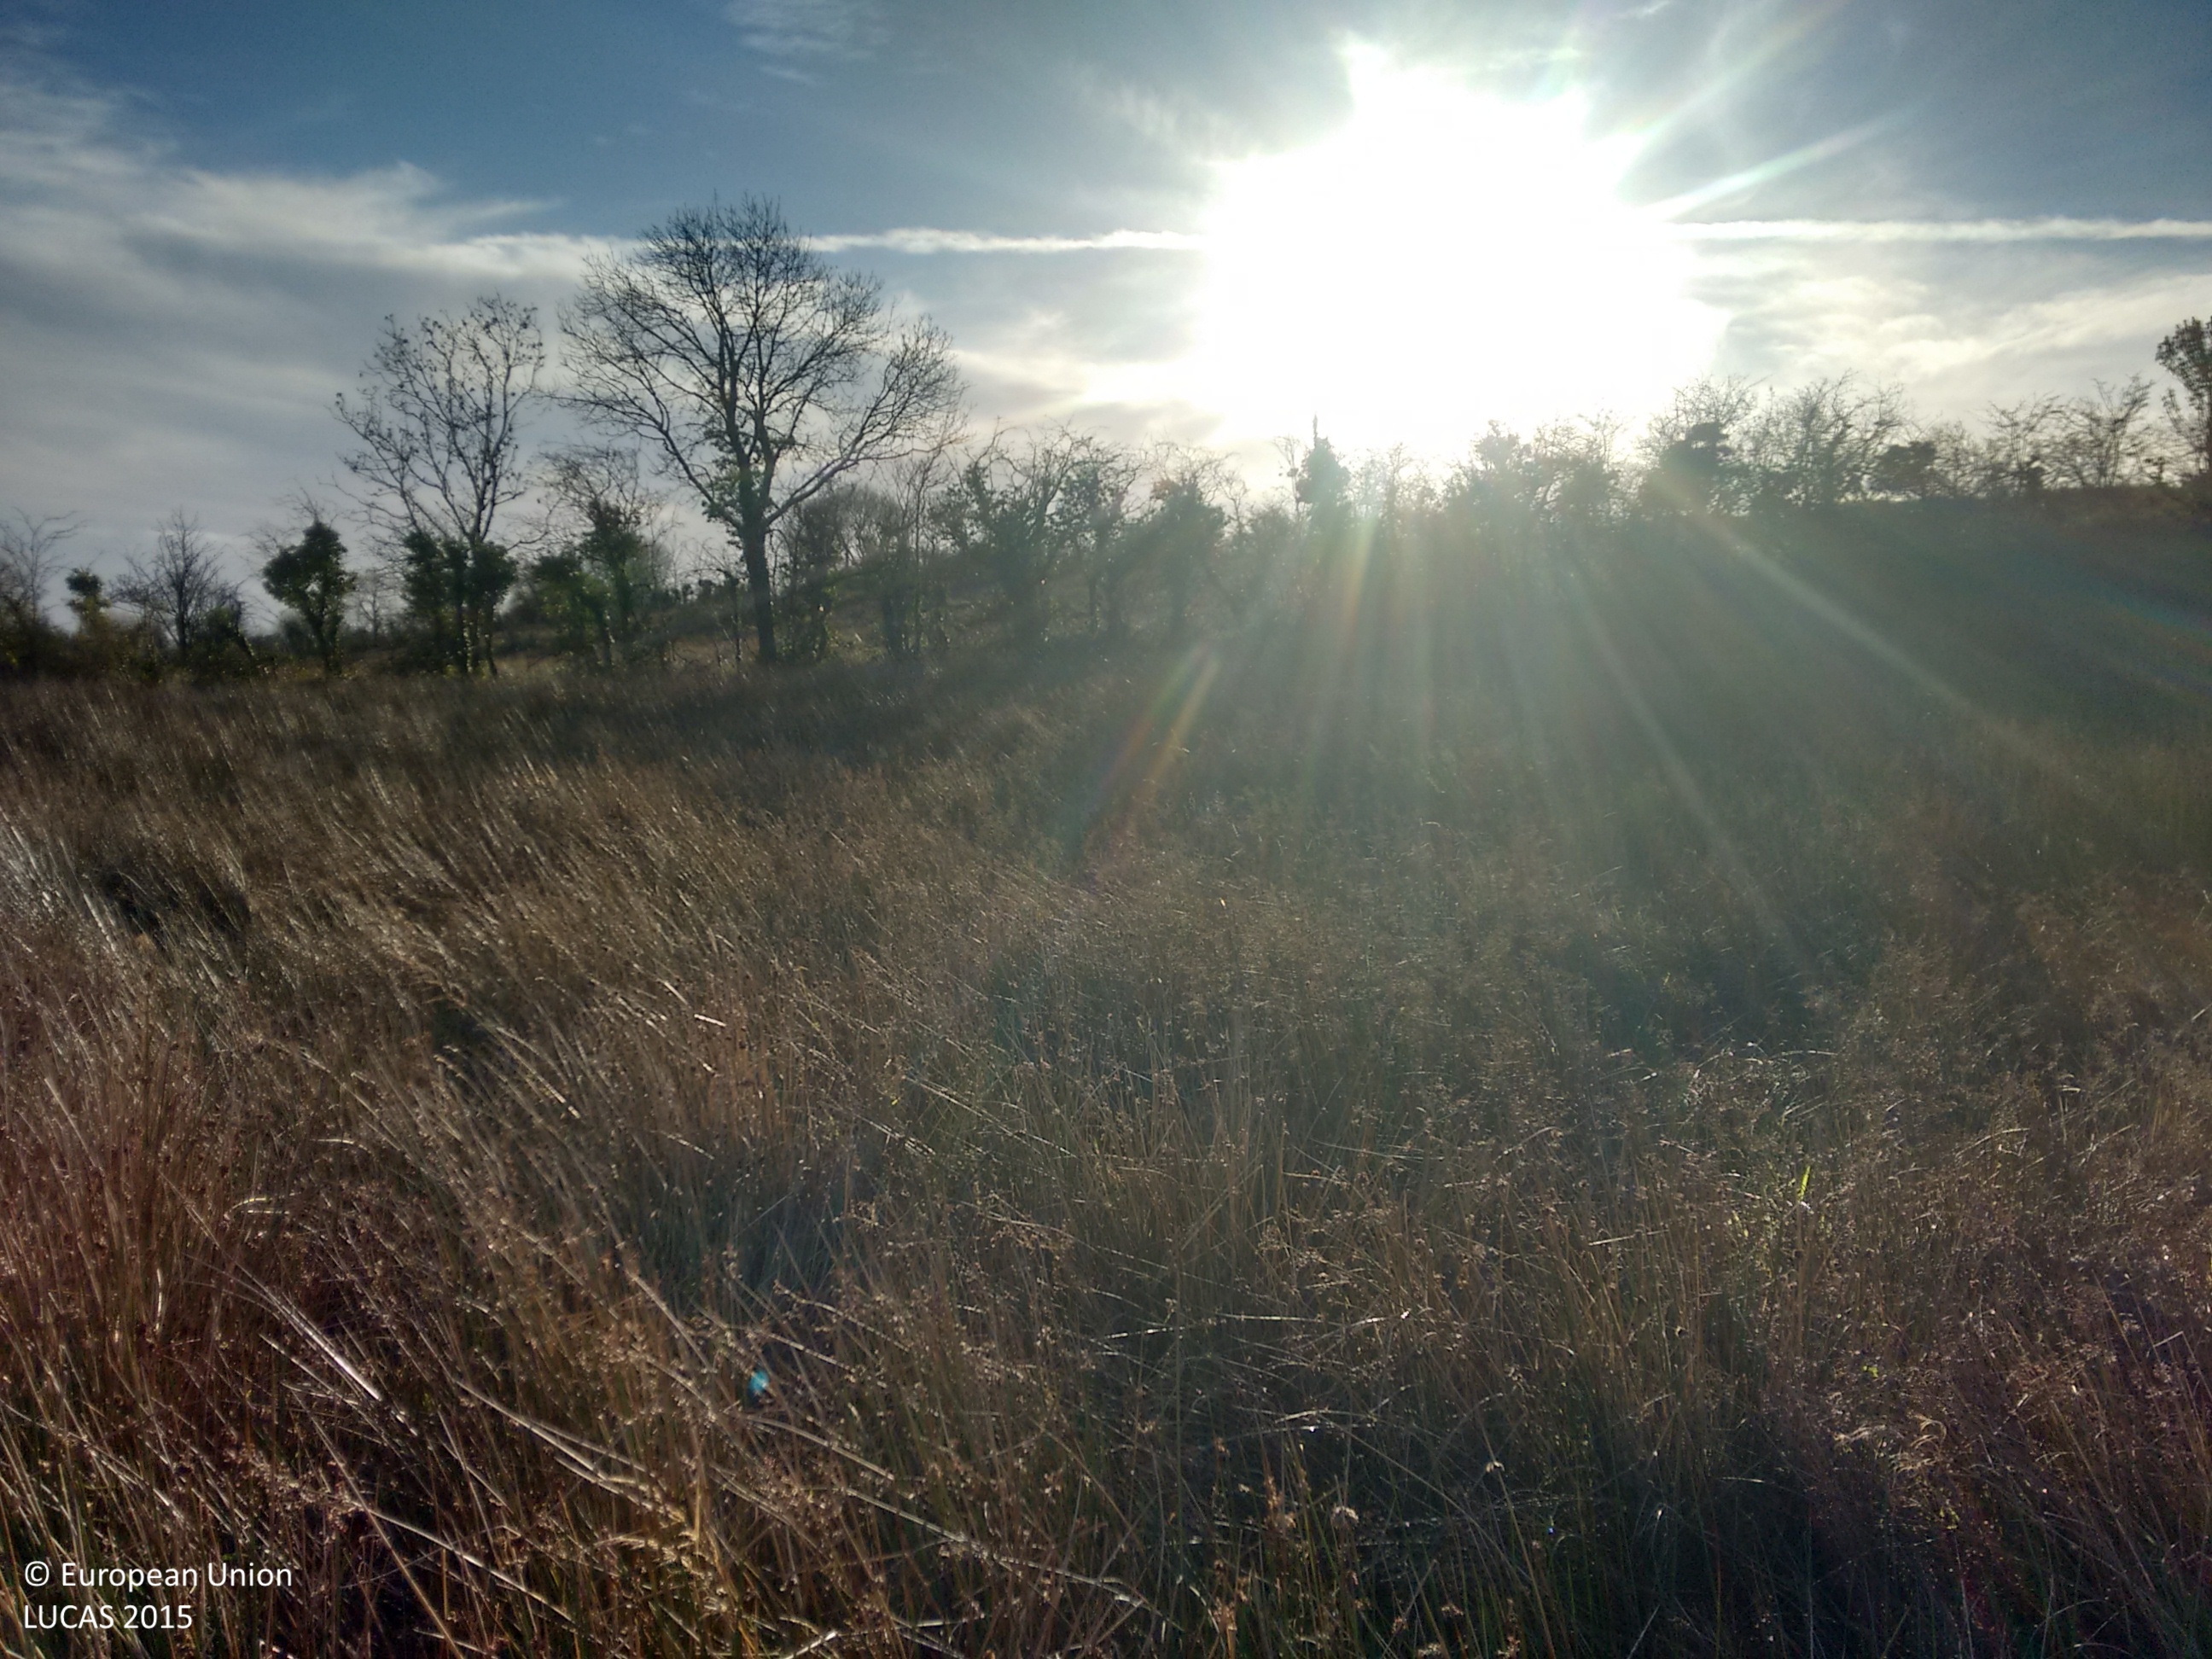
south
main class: Grassland
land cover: Grassland without tree/shrub cover
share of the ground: > 75 %
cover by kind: herbaceous plants 100 %
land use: Agriculture (excluding fallow land and kitchen gardens)
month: November
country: IE
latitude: 53.9752
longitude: -7.8710
